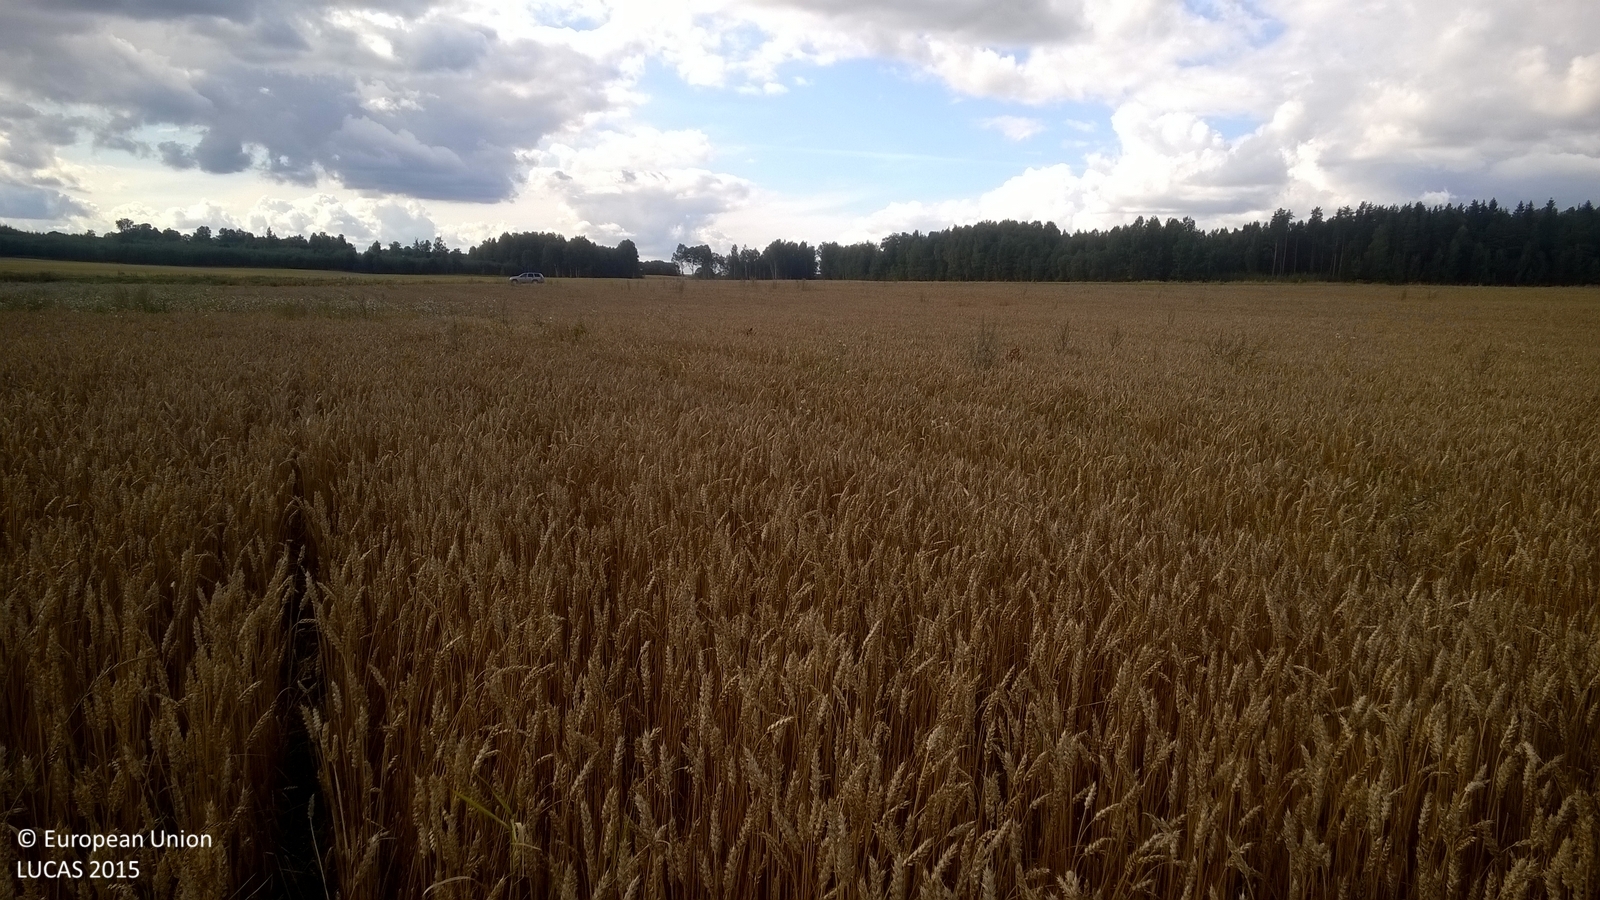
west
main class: Cropland
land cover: Common wheat
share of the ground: > 75 %
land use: Agriculture (excluding fallow land and kitchen gardens)
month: August
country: LV
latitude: 57.3904
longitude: 25.9155
